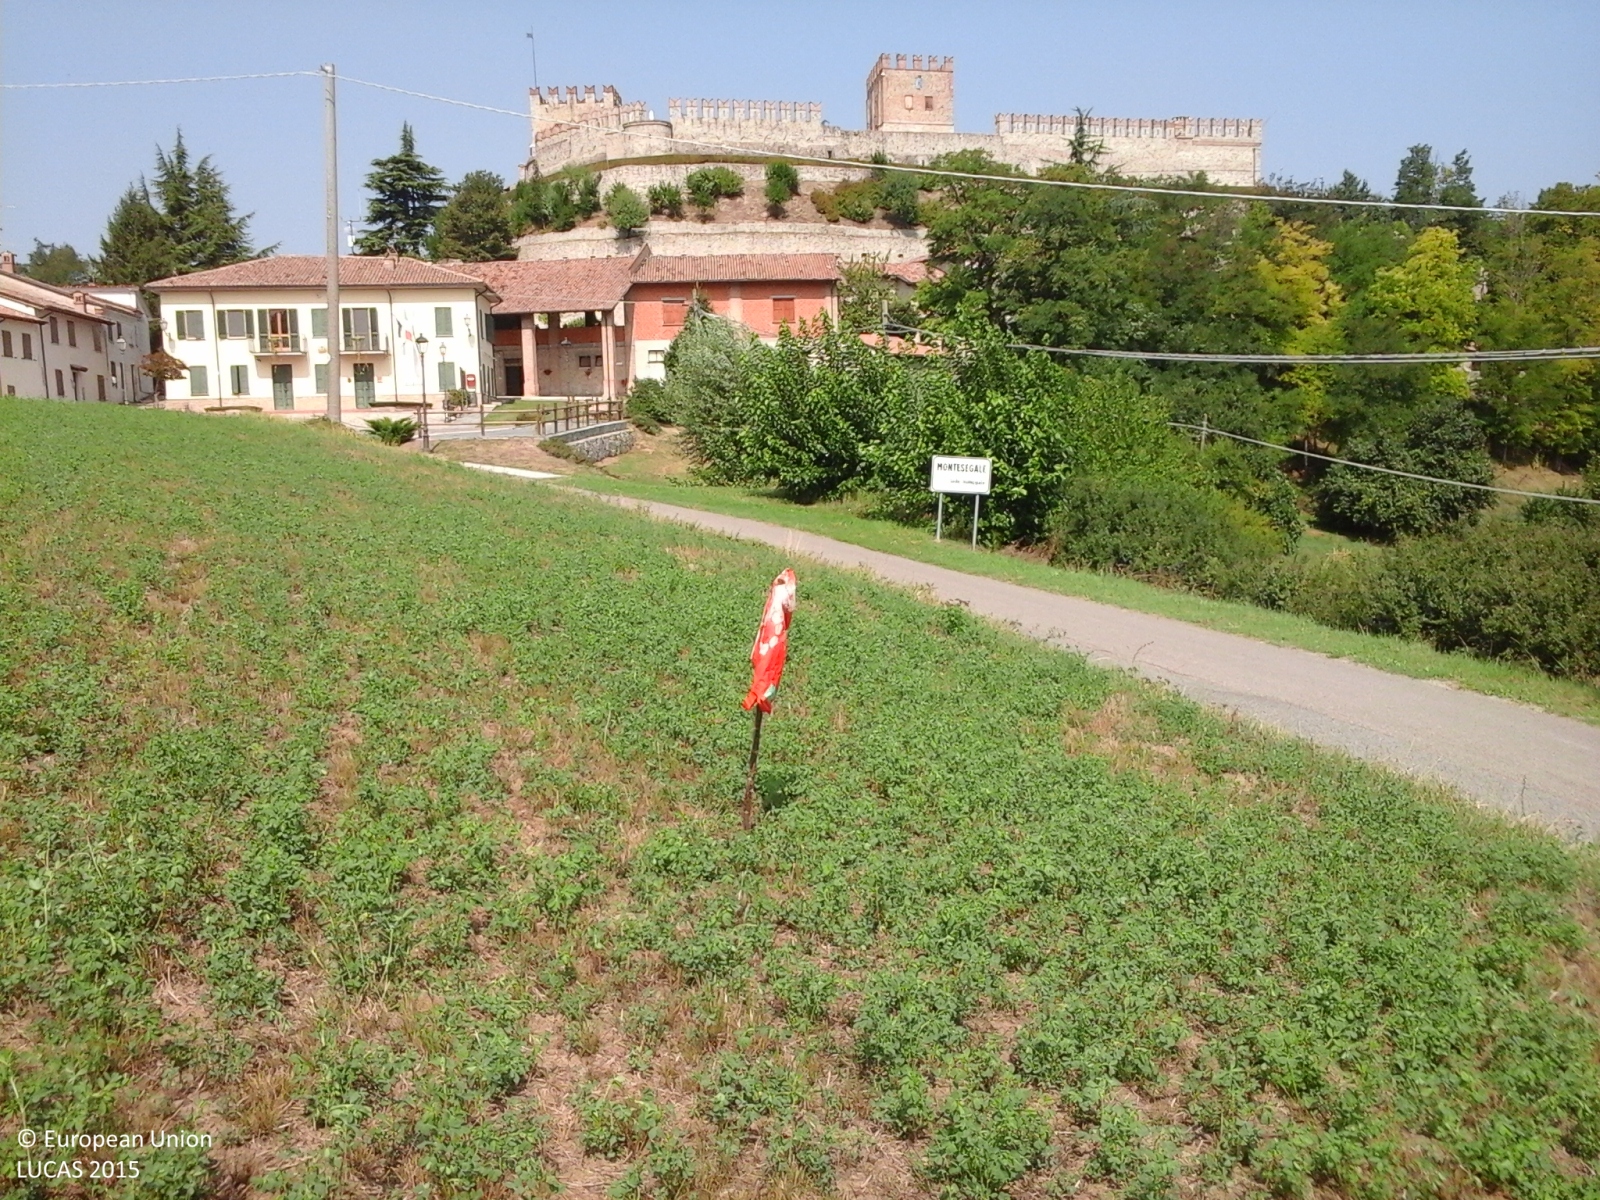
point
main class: Cropland
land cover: Lucerne
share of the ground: > 75 %
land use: Agriculture (excluding fallow land and kitchen gardens)
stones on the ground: < 10 %
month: August
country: IT
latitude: 44.9059
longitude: 9.1278
